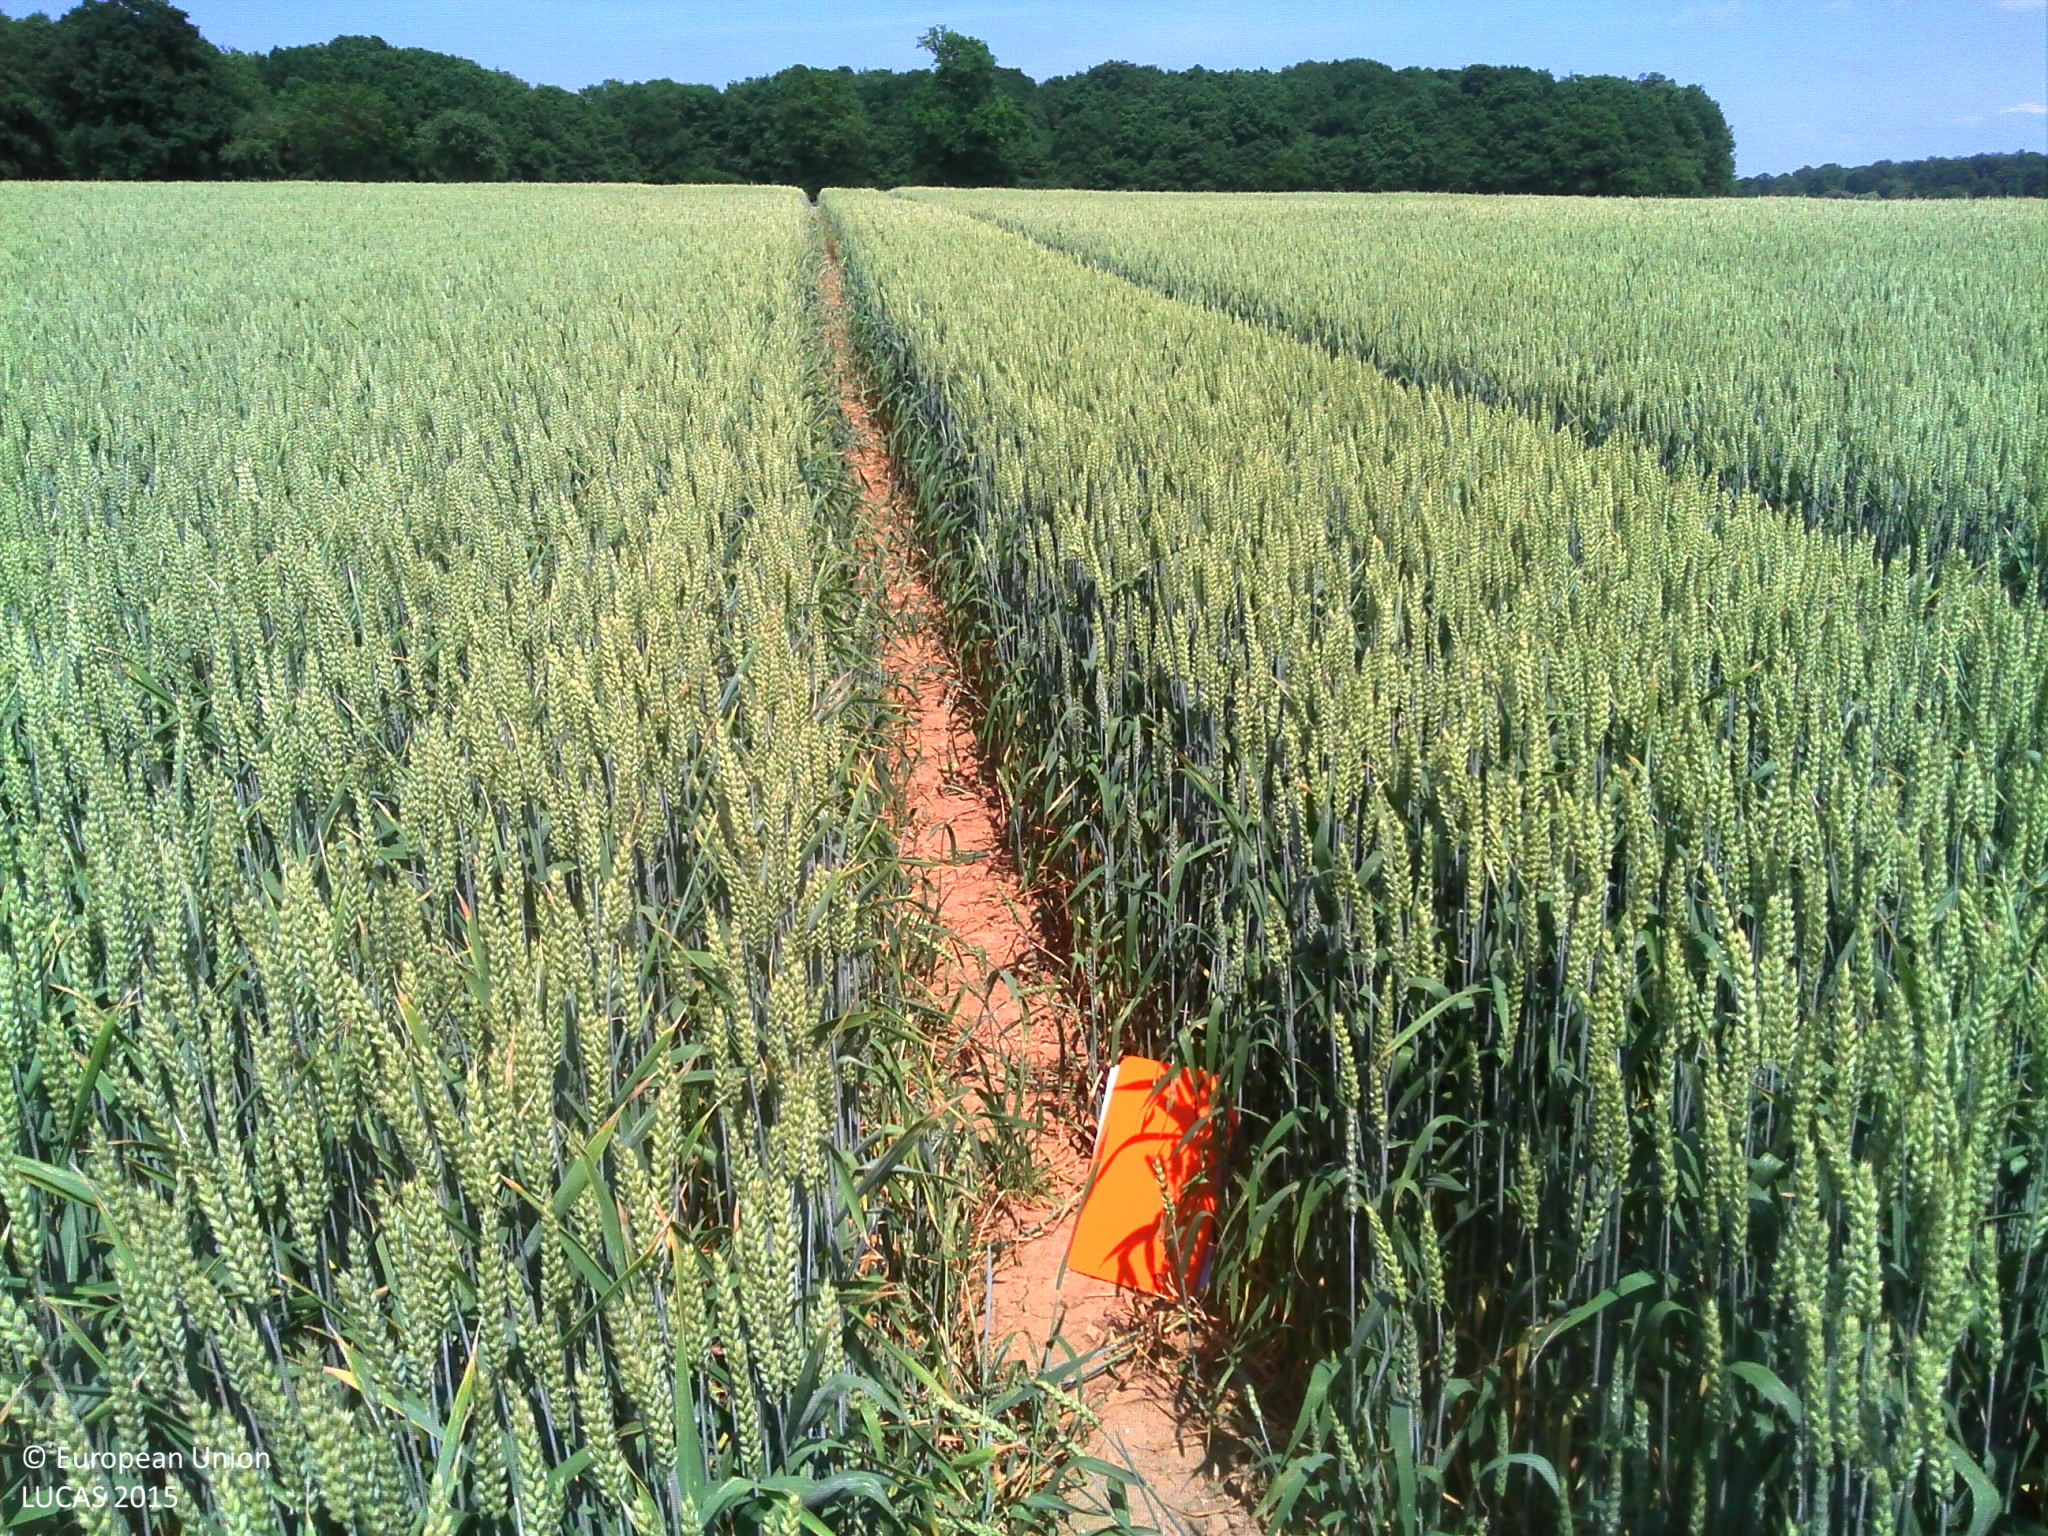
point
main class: Cropland
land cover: Common wheat
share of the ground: > 75 %
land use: Agriculture (excluding fallow land and kitchen gardens)
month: June
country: FR
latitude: 47.2331
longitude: 3.1403
